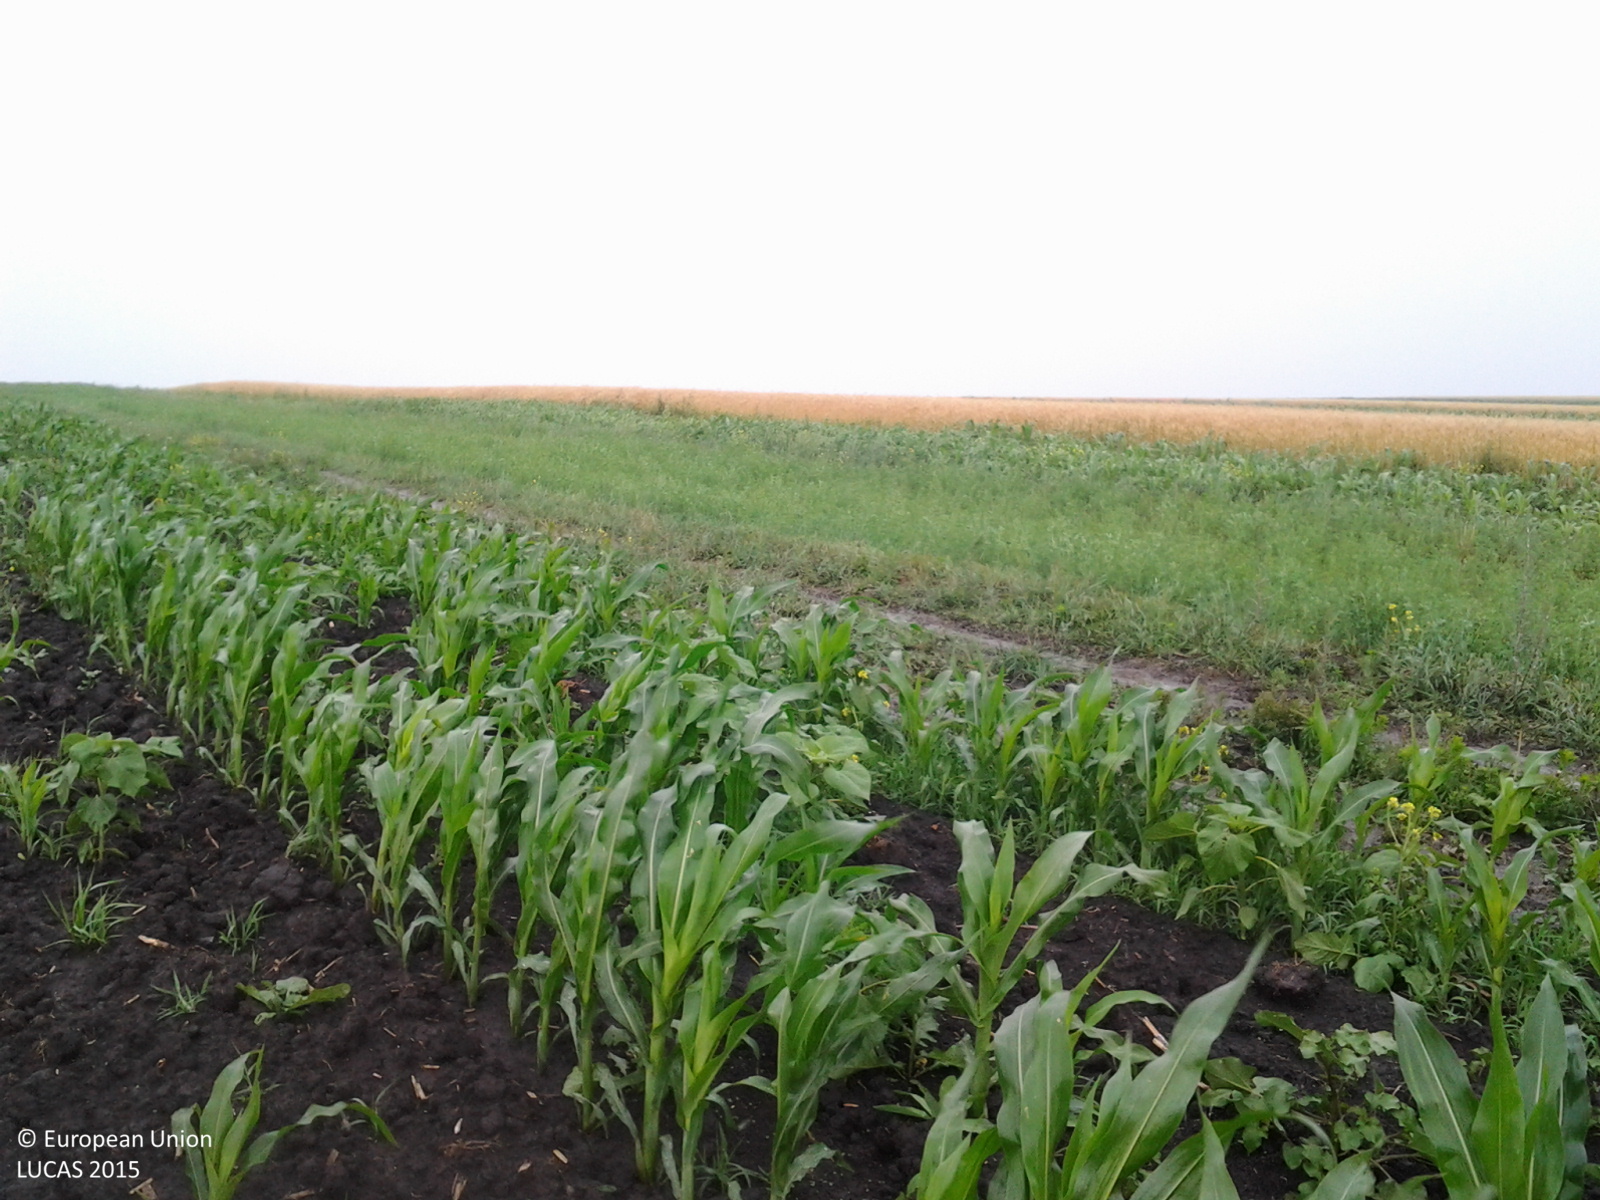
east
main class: Cropland
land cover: Maize
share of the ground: 10 - 25 %
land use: Agriculture (excluding fallow land and kitchen gardens)
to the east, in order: Maize; Tracks; Lucerne; Maize; Common wheat; Maize; Lucerne; Maize; Common wheat; Lucerne
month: June
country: RO
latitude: 47.9004
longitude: 26.5326
